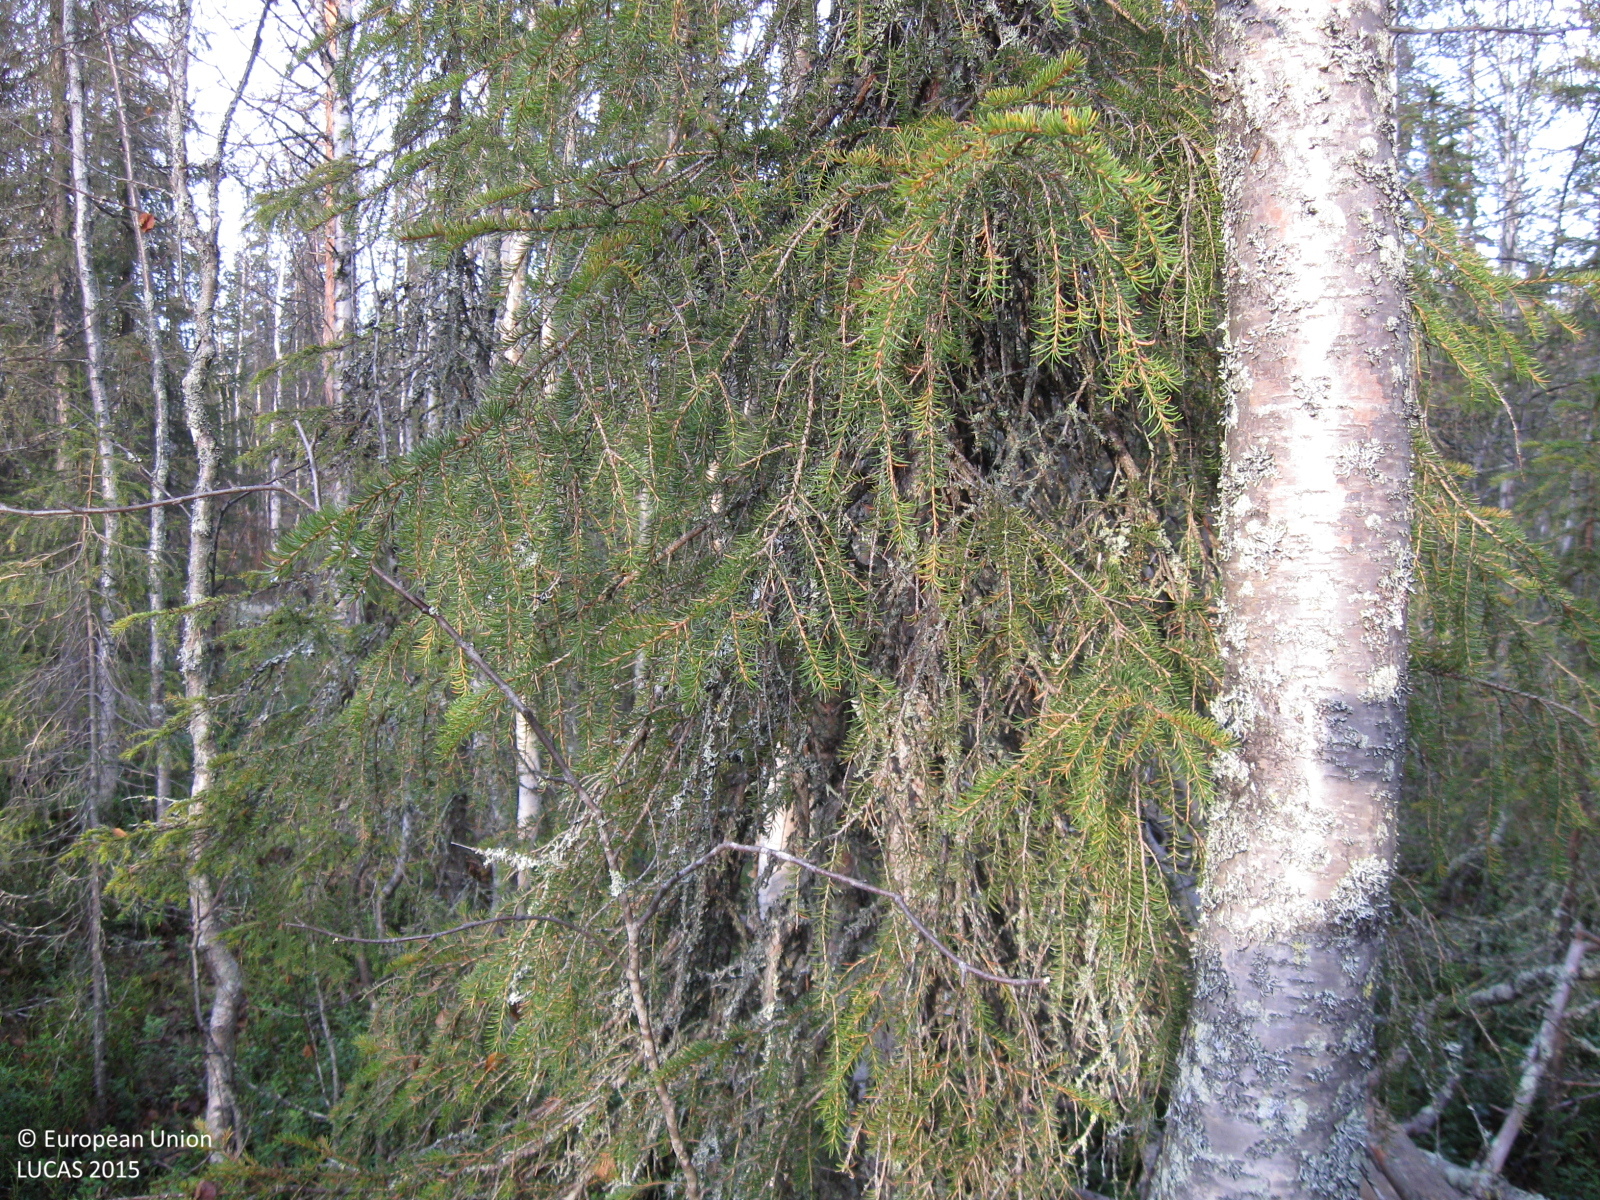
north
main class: Woodland
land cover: Spruce dominated mixed woodland
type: boreal forest
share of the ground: > 75 %
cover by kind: broadleaved forest trees 65 %, coniferous forest trees 25 %, shrubs 5 %, herbaceous plants 5 %
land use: Forestry
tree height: > 5 m
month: October
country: SE
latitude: 66.3873
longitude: 21.6212
